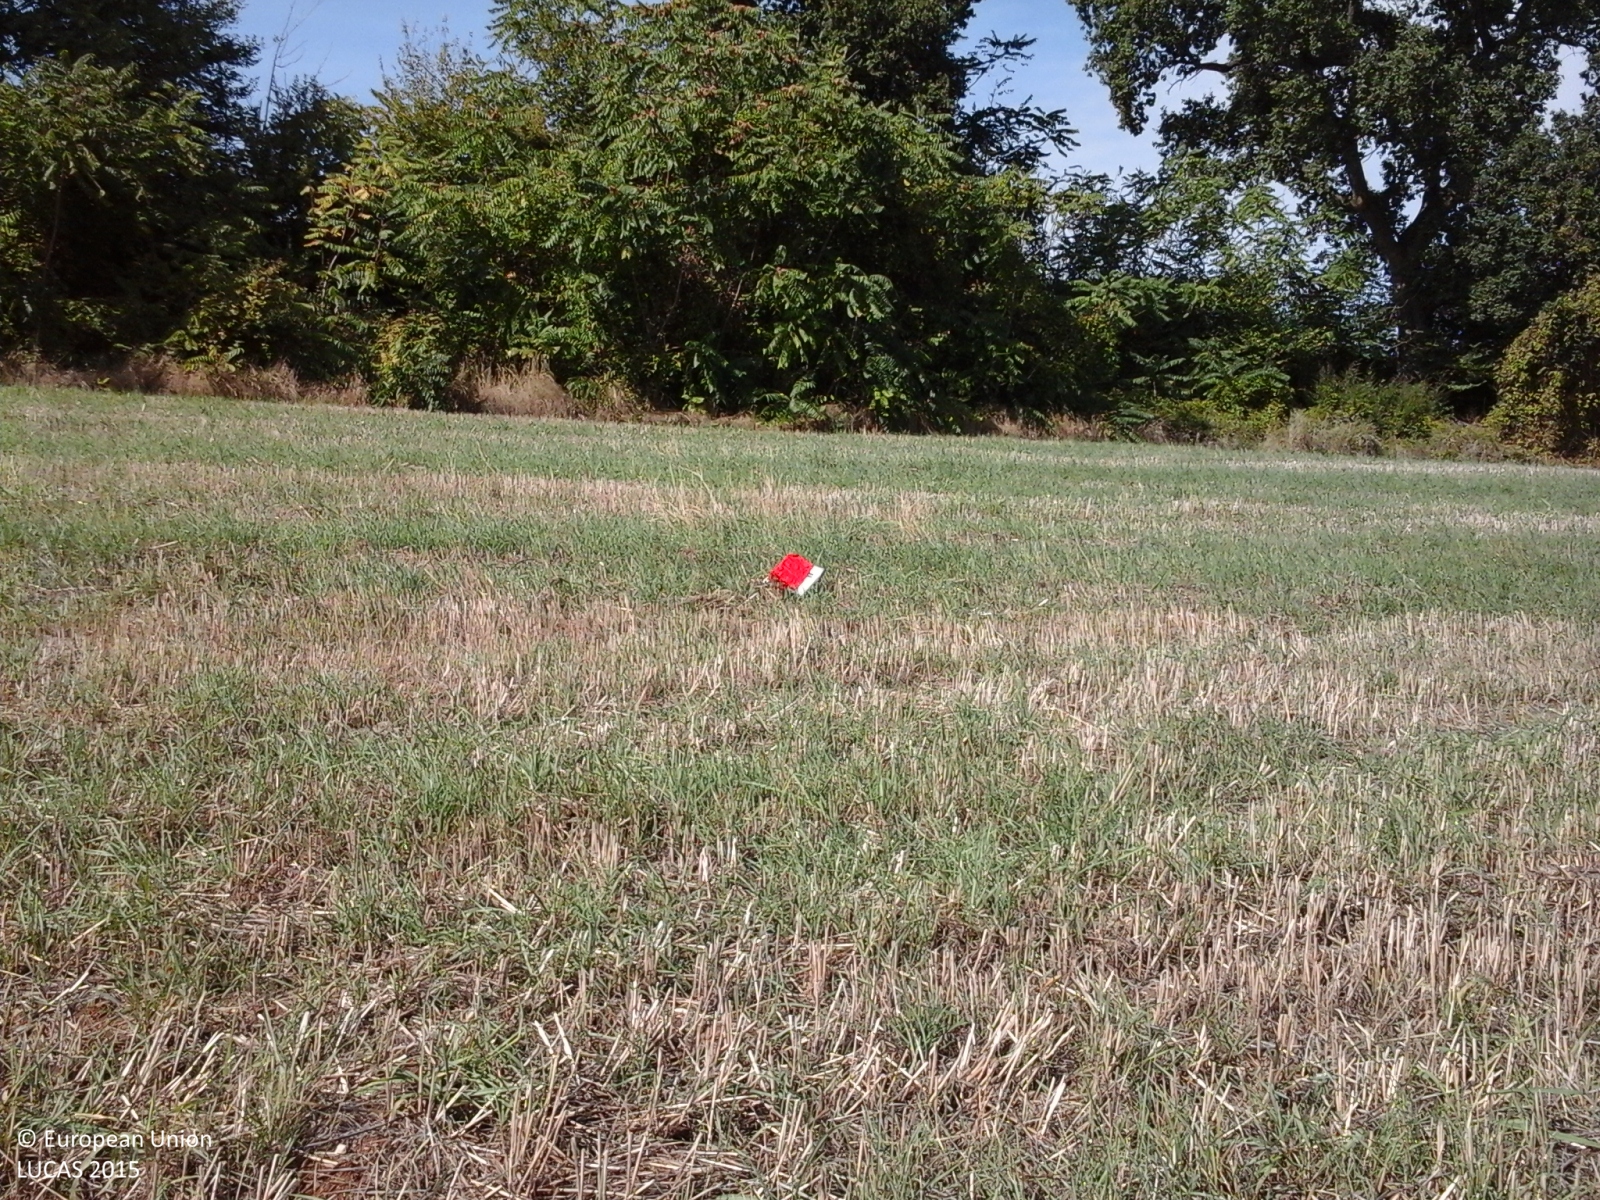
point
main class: Cropland
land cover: Common wheat
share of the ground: > 75 %
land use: Agriculture (excluding fallow land and kitchen gardens)
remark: Harvested field
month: September
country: IT
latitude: 42.8522
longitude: 13.8442
